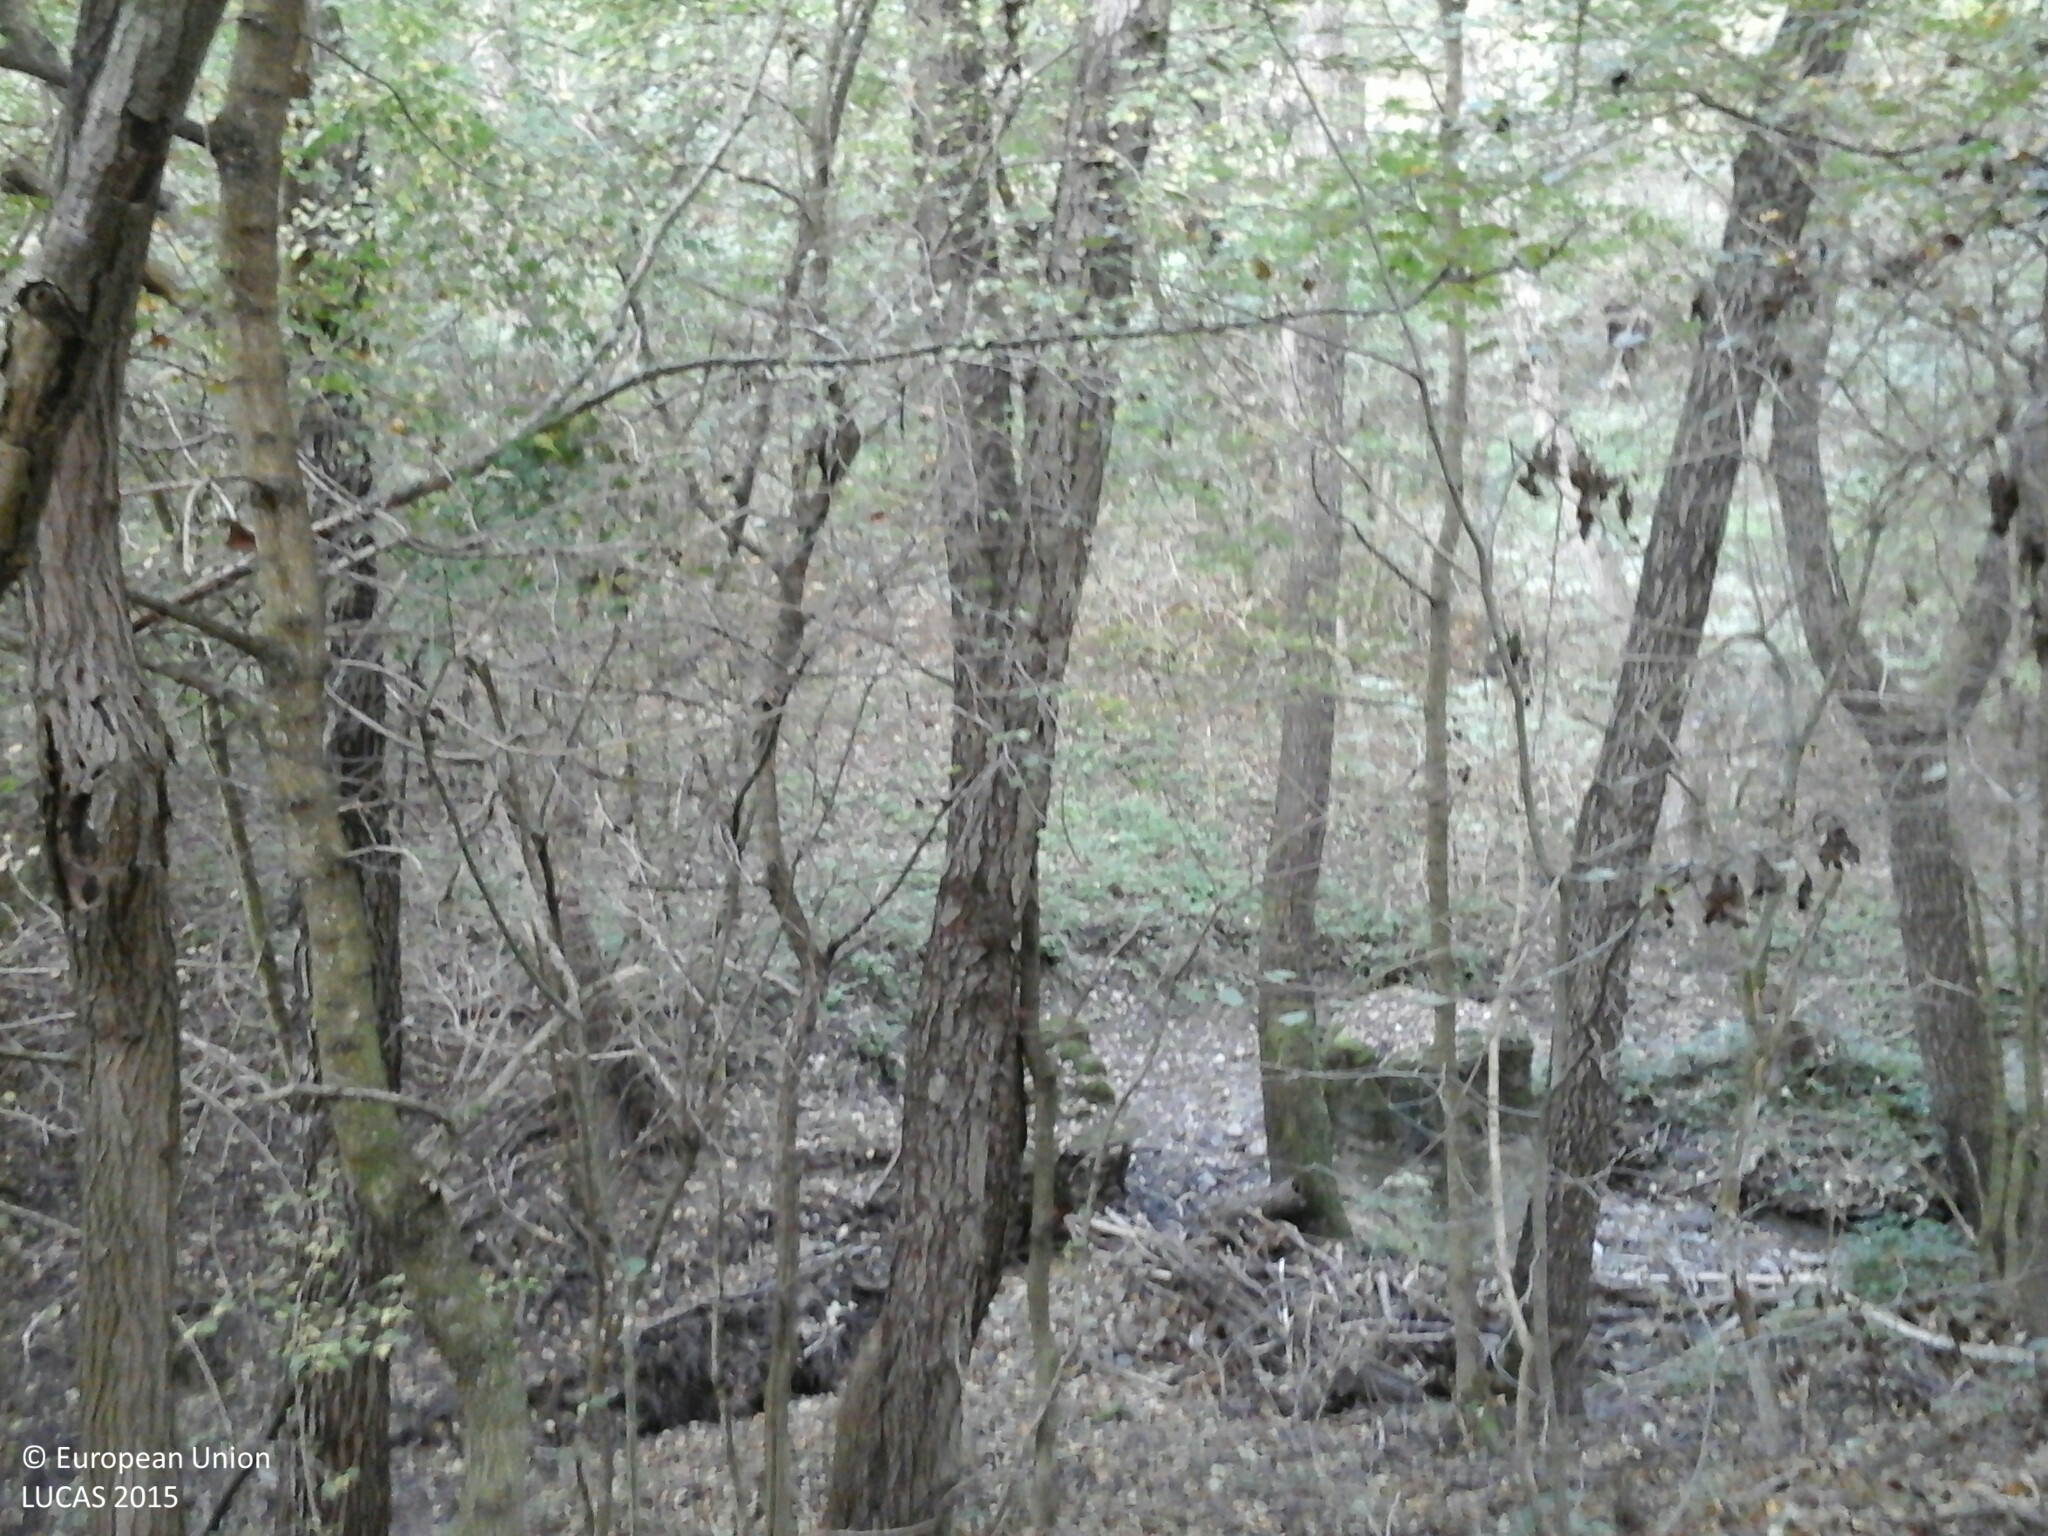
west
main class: Woodland
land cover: Broadleaved woodland
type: mesophytic deciduous forest
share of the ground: > 75 %
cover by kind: broadleaved forest trees 90 %, shrubs 5 %, herbaceous plants 5 %
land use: Forestry
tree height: > 5 m
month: September
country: HU
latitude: 47.9633
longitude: 19.8435
